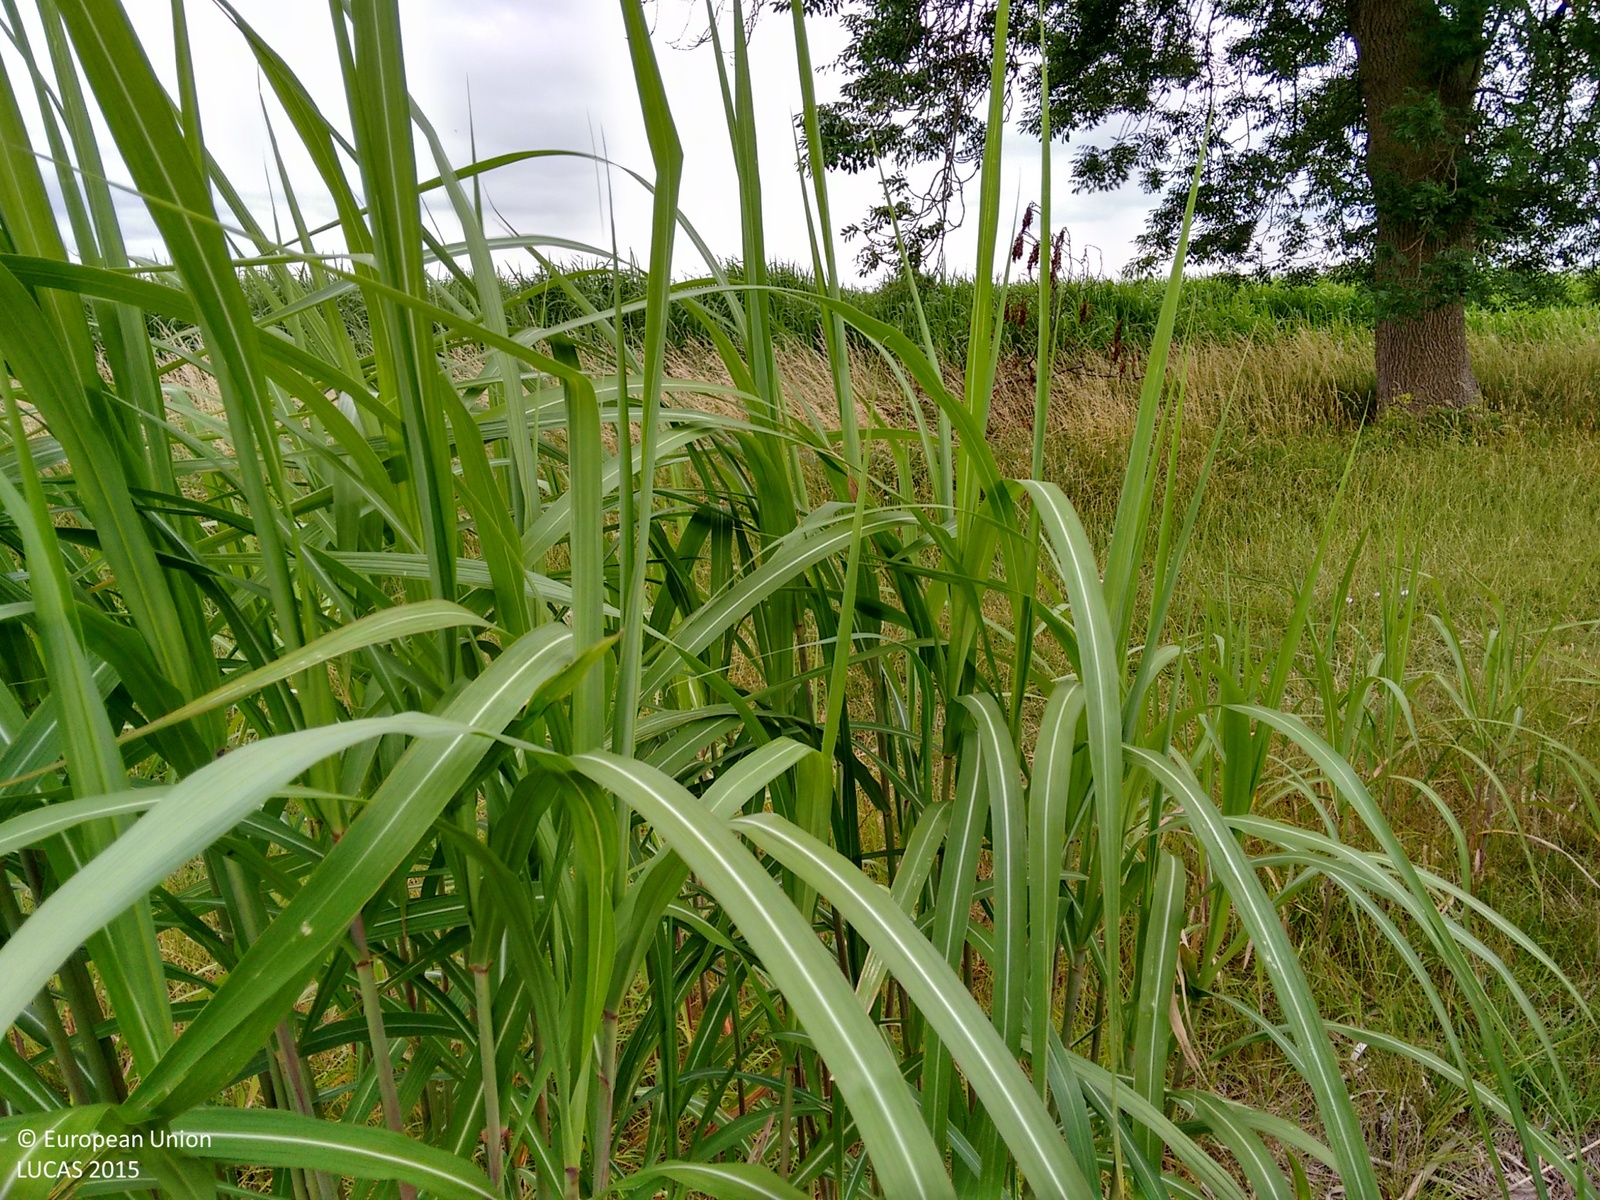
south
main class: Cropland
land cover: Permanent industrial crops
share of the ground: > 75 %
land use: Agriculture (excluding fallow land and kitchen gardens)
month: July
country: GB
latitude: 52.5077
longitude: -0.5137
